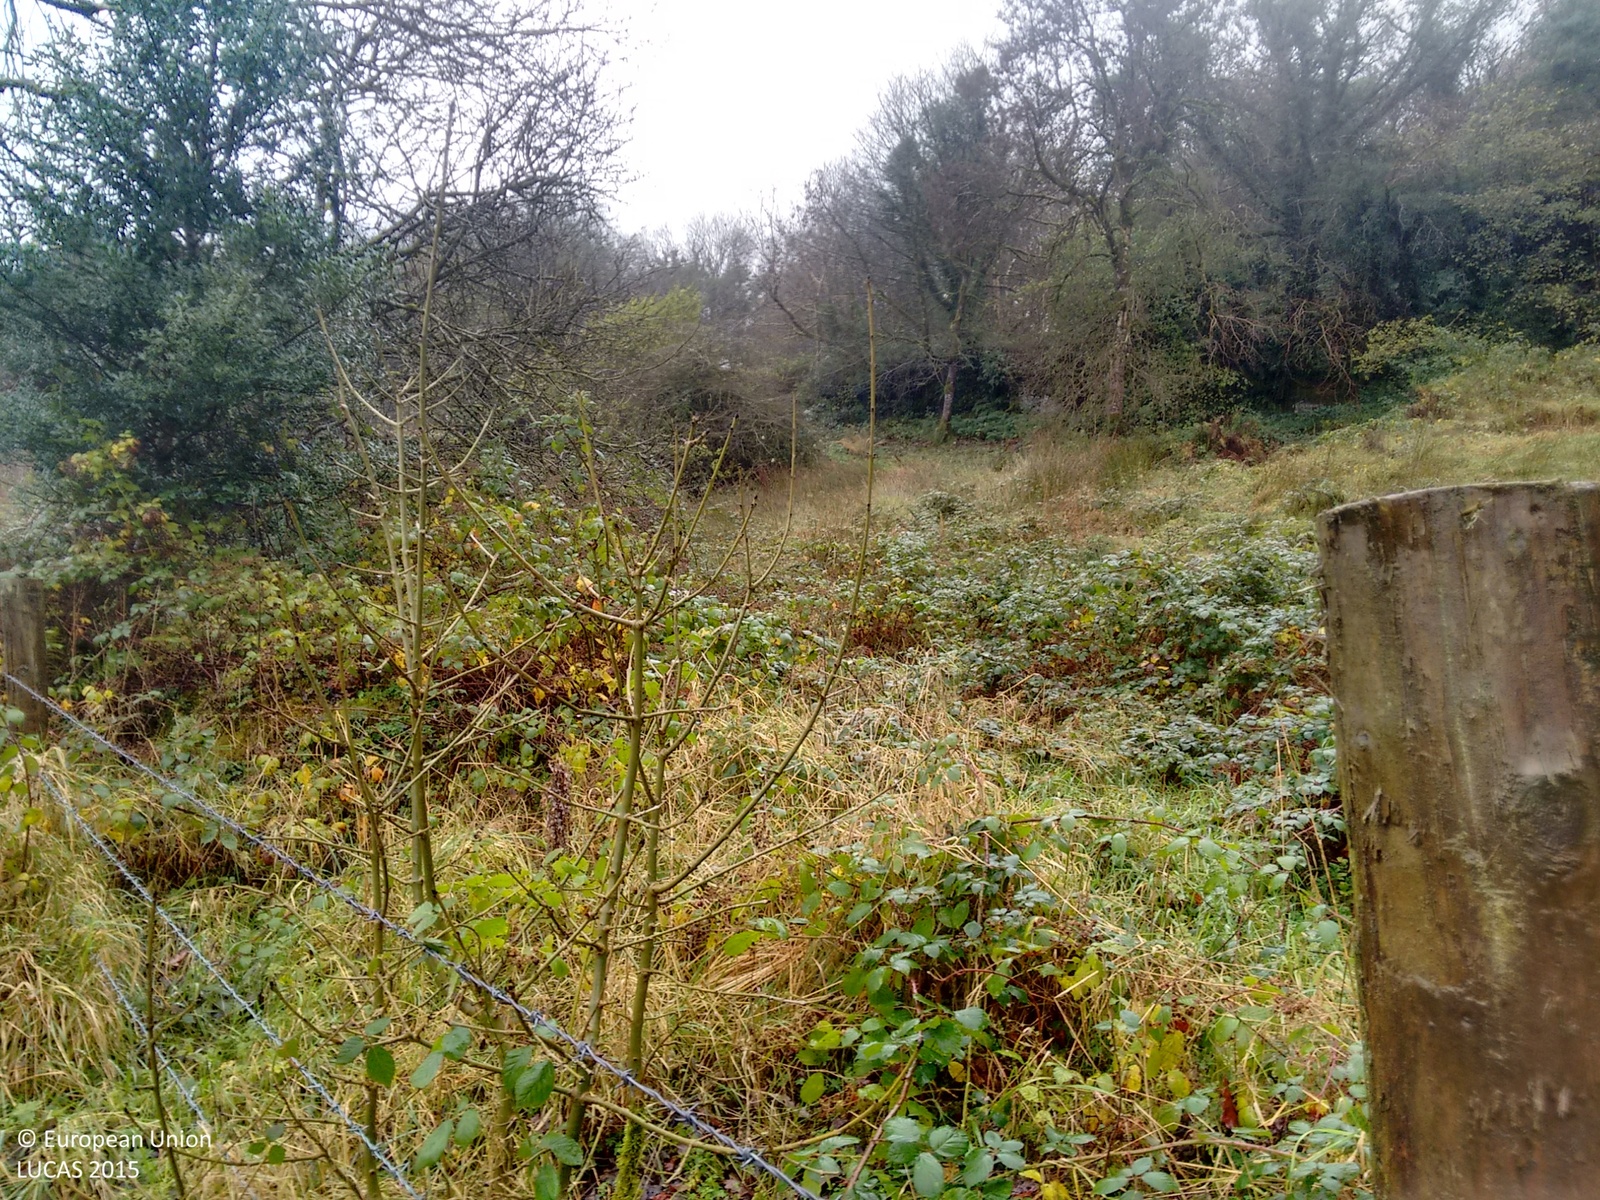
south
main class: Woodland
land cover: Broadleaved woodland
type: exotic forest
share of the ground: > 75 %
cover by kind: broadleaved forest trees 50 %, shrubs 40 %, herbaceous plants 10 %
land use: Agriculture (excluding fallow land and kitchen gardens)
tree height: > 5 m
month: November
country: IE
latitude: 54.0513
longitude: -8.3479
